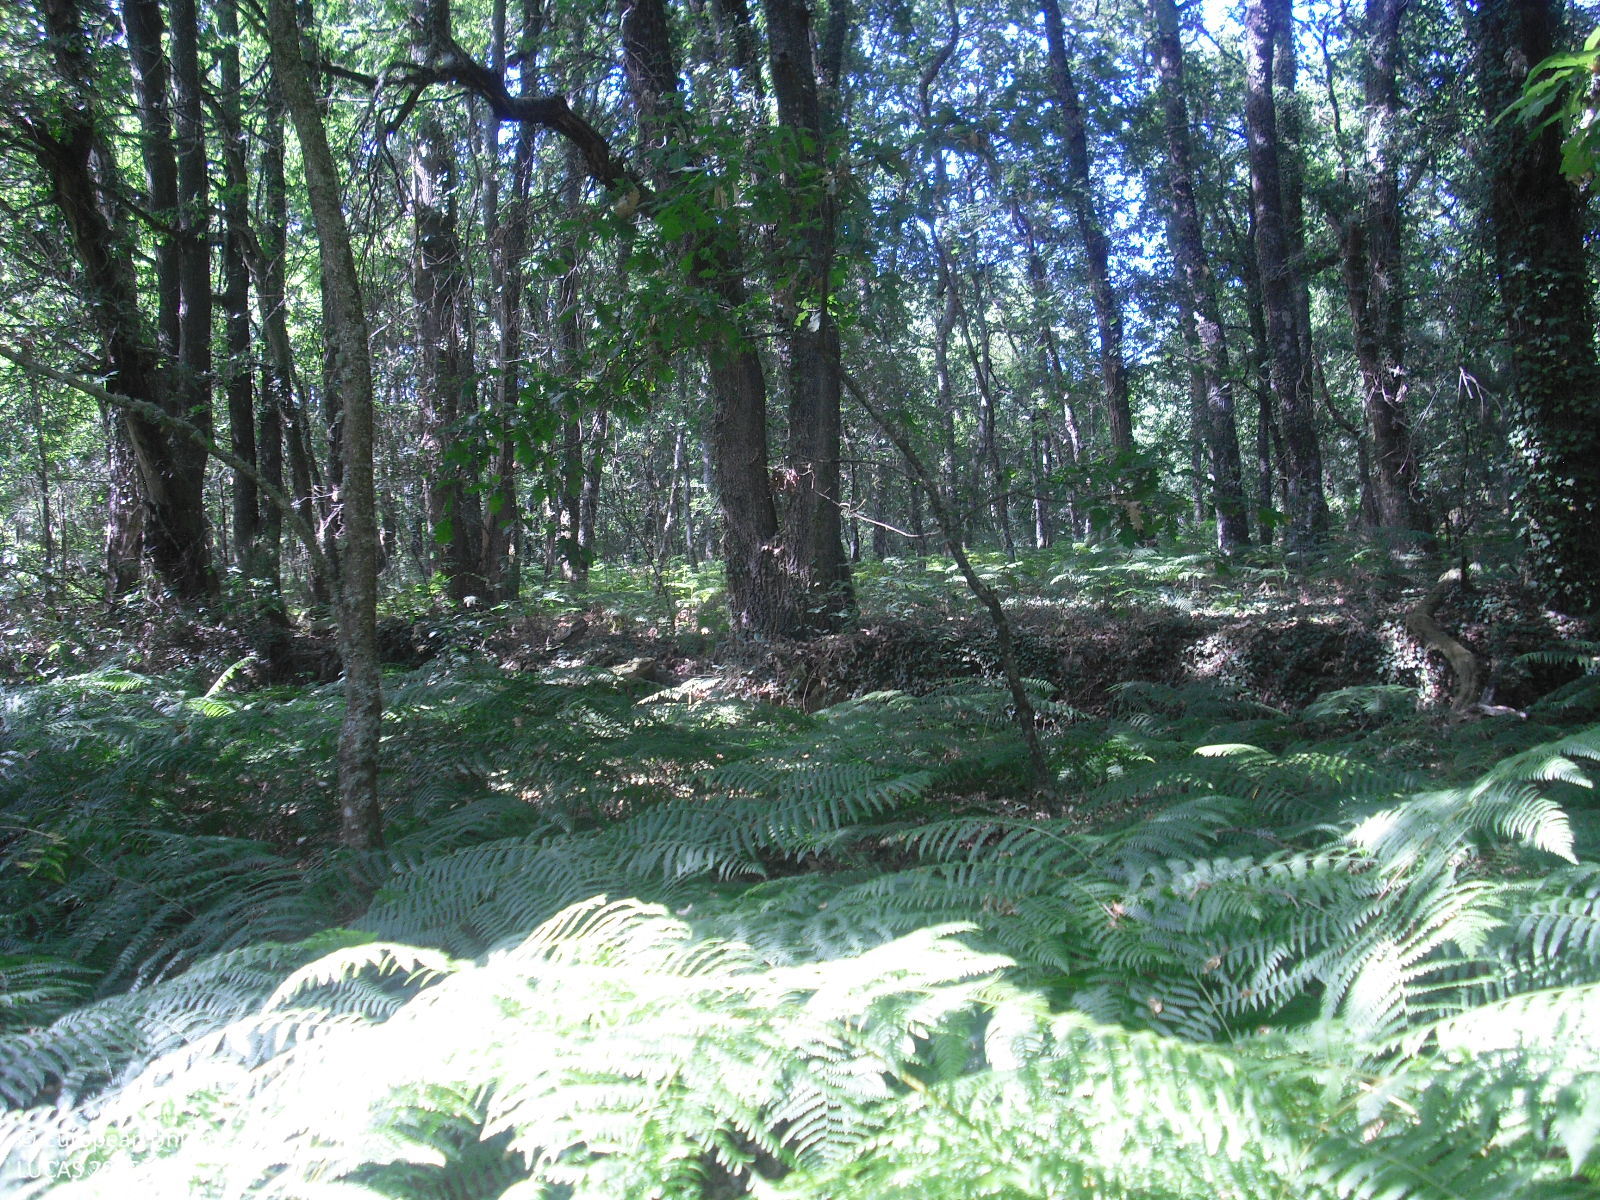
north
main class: Woodland
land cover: Broadleaved woodland
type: thermophilous deciduous forest
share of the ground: 50 - 75 %
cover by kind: broadleaved forest trees 70 %, shrubs 30 %
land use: Forestry
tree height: > 5 m
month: July
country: ES
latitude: 42.2942
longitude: -7.7199
